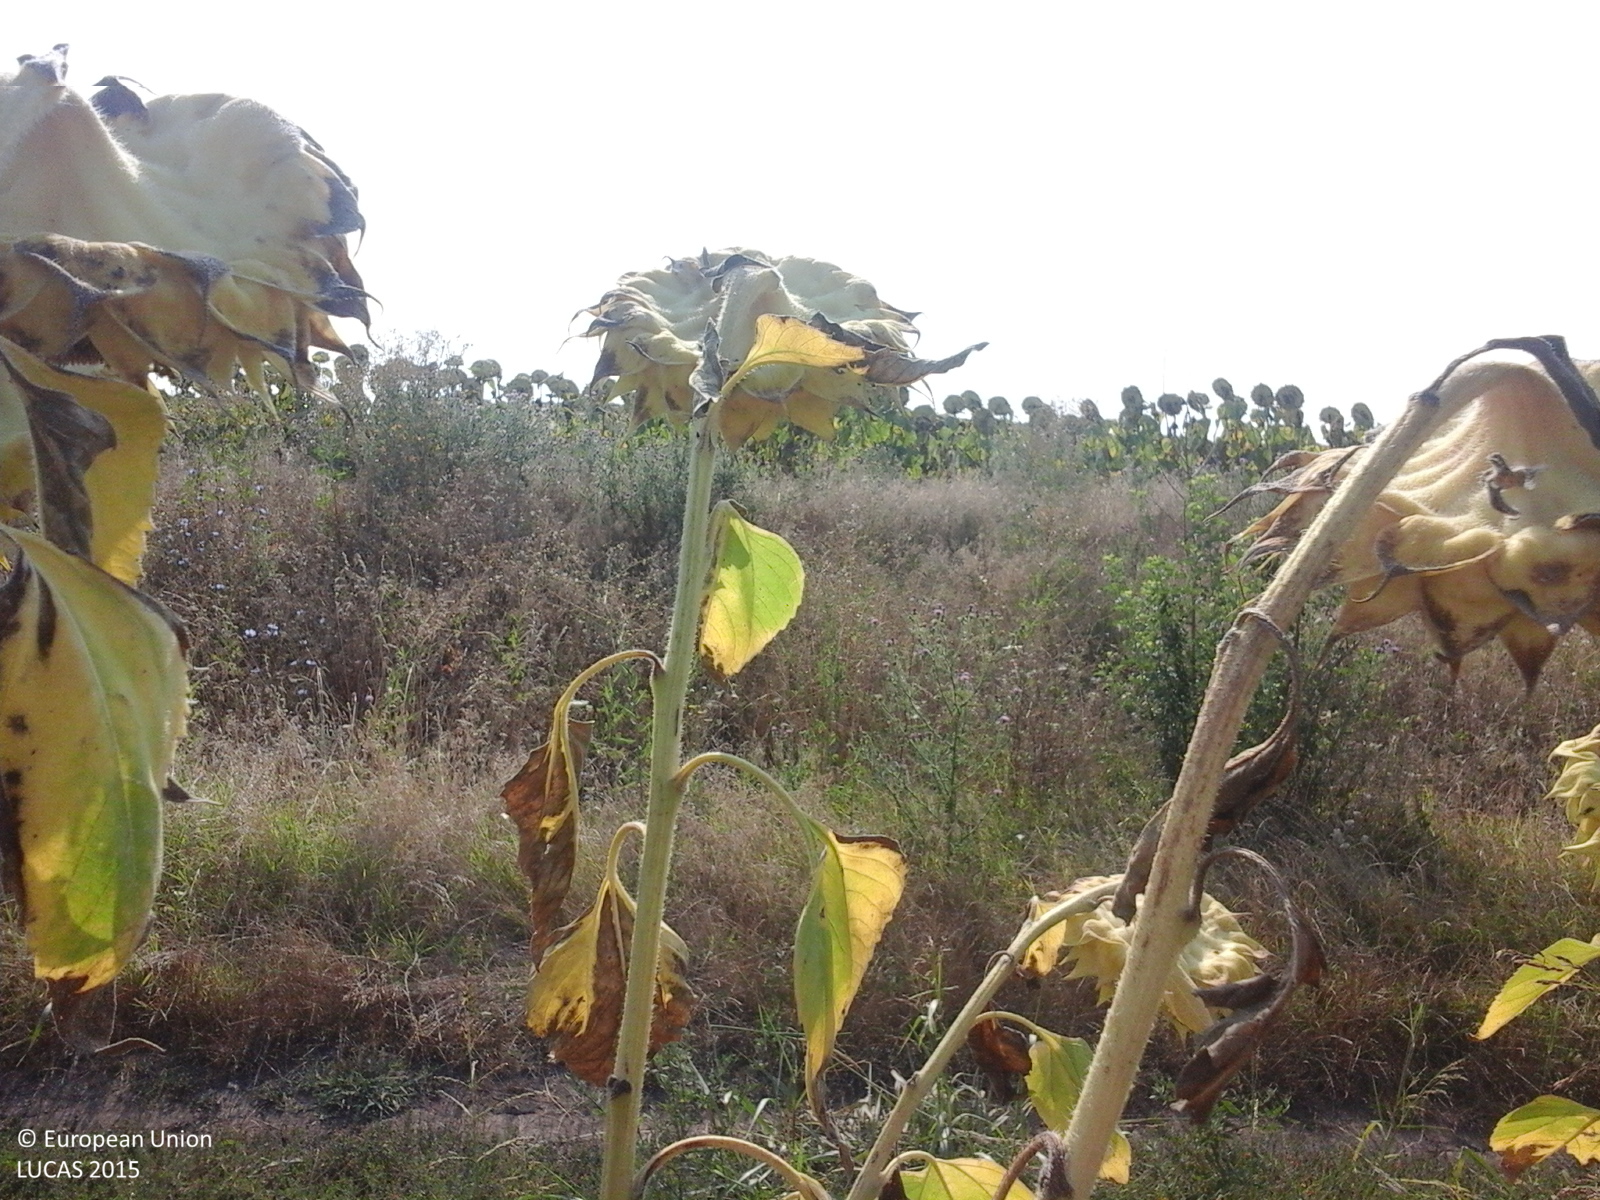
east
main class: Cropland
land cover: Sunflower
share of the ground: > 75 %
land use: Agriculture (excluding fallow land and kitchen gardens)
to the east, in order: Sunflower; Tracks; Ditches and canals; Grass margins; Sunflower; Common wheat; Sunflower
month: August
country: RO
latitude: 43.9333
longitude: 23.2616
